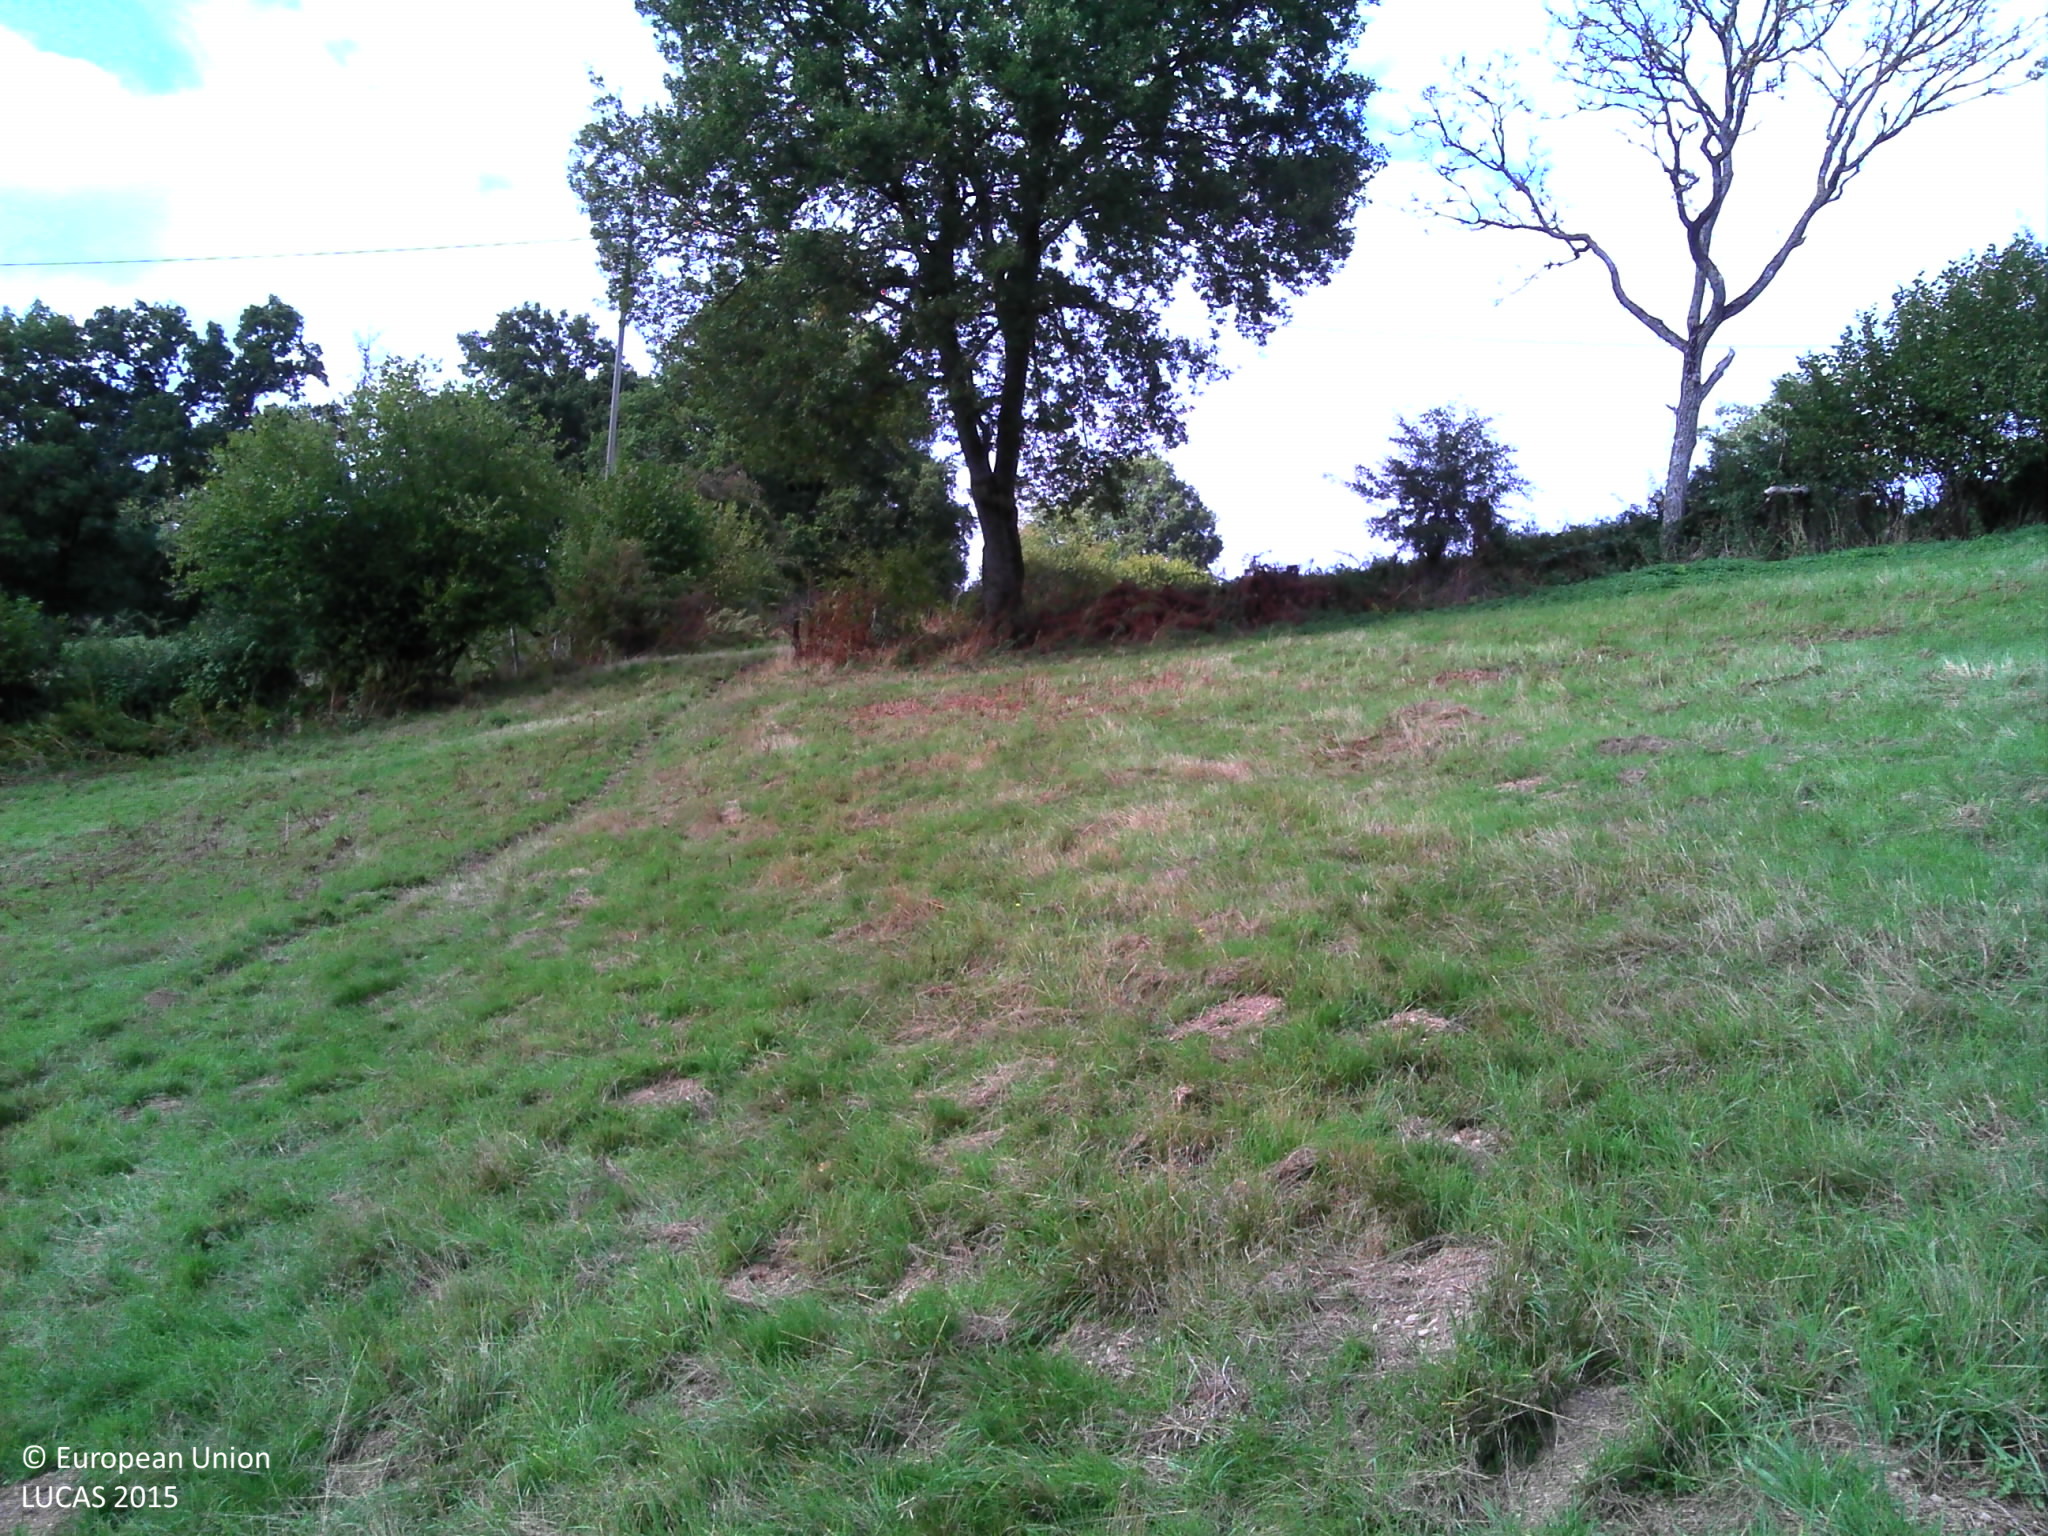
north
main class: Grassland
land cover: Grassland without tree/shrub cover
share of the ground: > 75 %
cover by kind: herbaceous plants 100 %
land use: Agriculture (excluding fallow land and kitchen gardens)
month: September
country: FR
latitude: 46.1830
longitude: 2.8333
